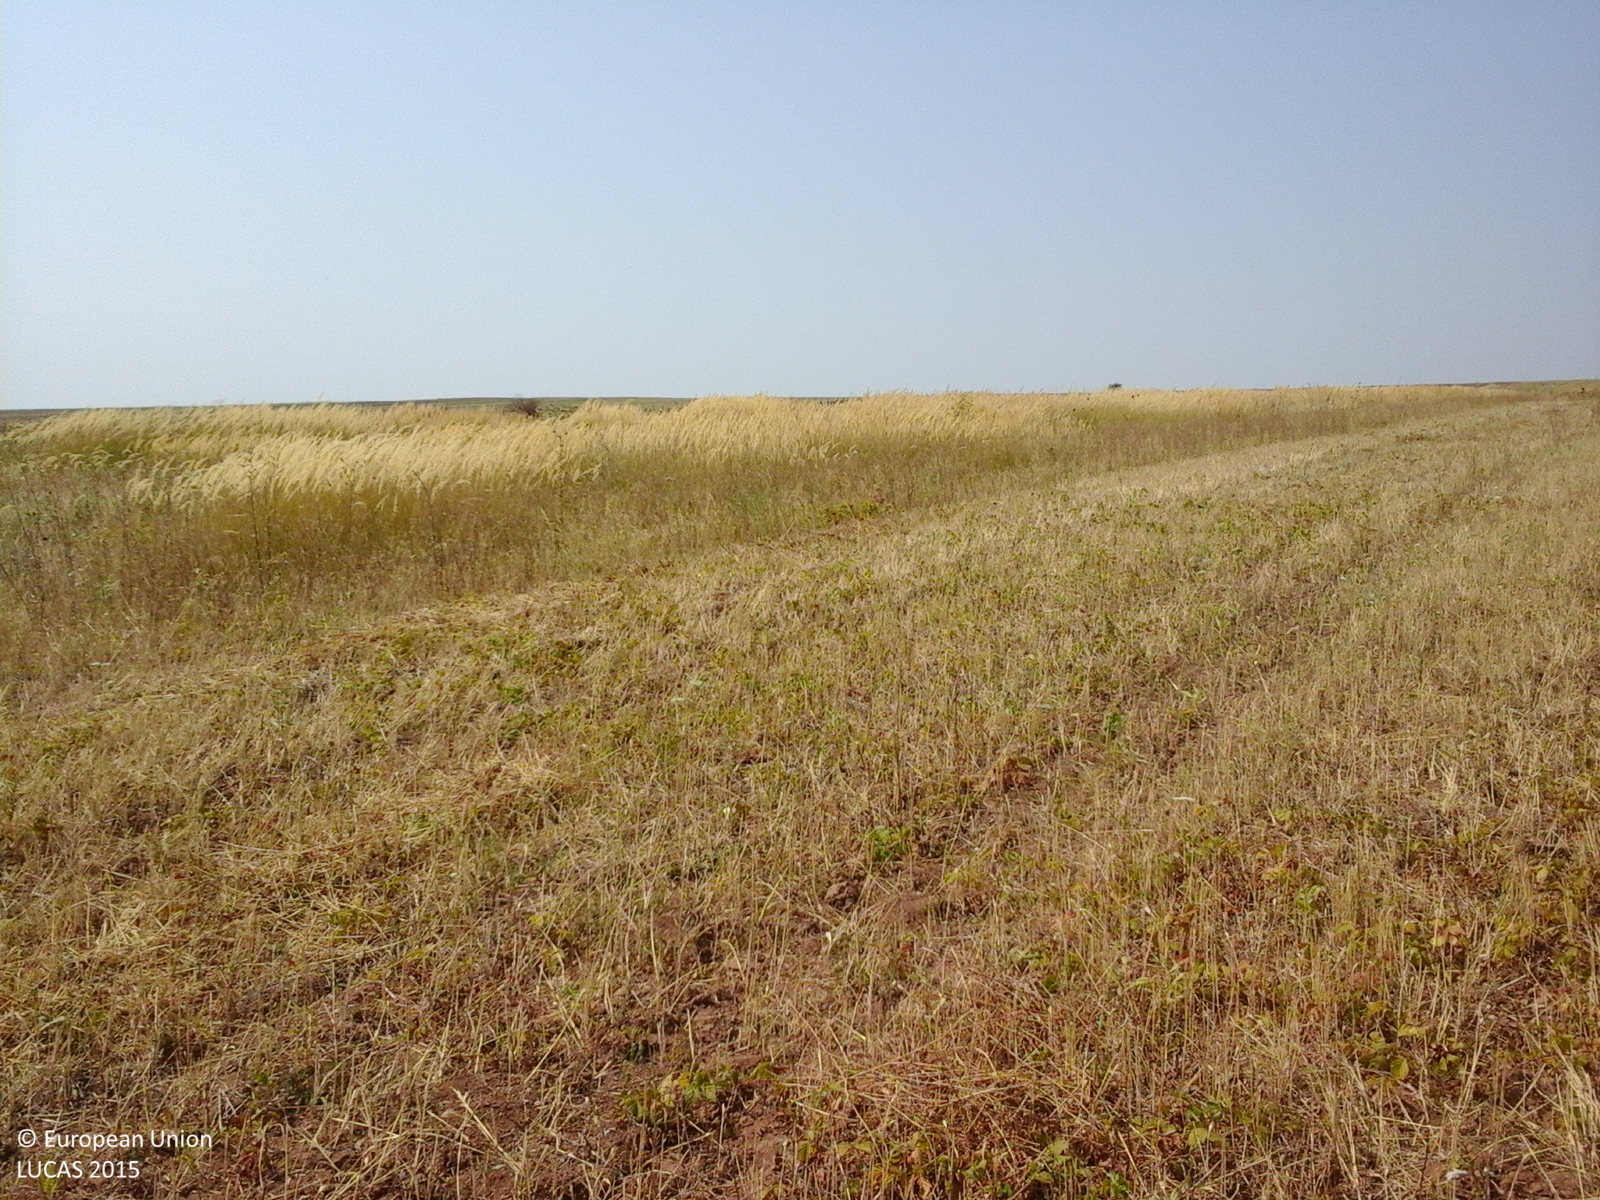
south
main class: Cropland
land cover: Durum wheat
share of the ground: > 75 %
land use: Agriculture (excluding fallow land and kitchen gardens)
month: August
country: RO
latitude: 44.4268
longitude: 22.9700
